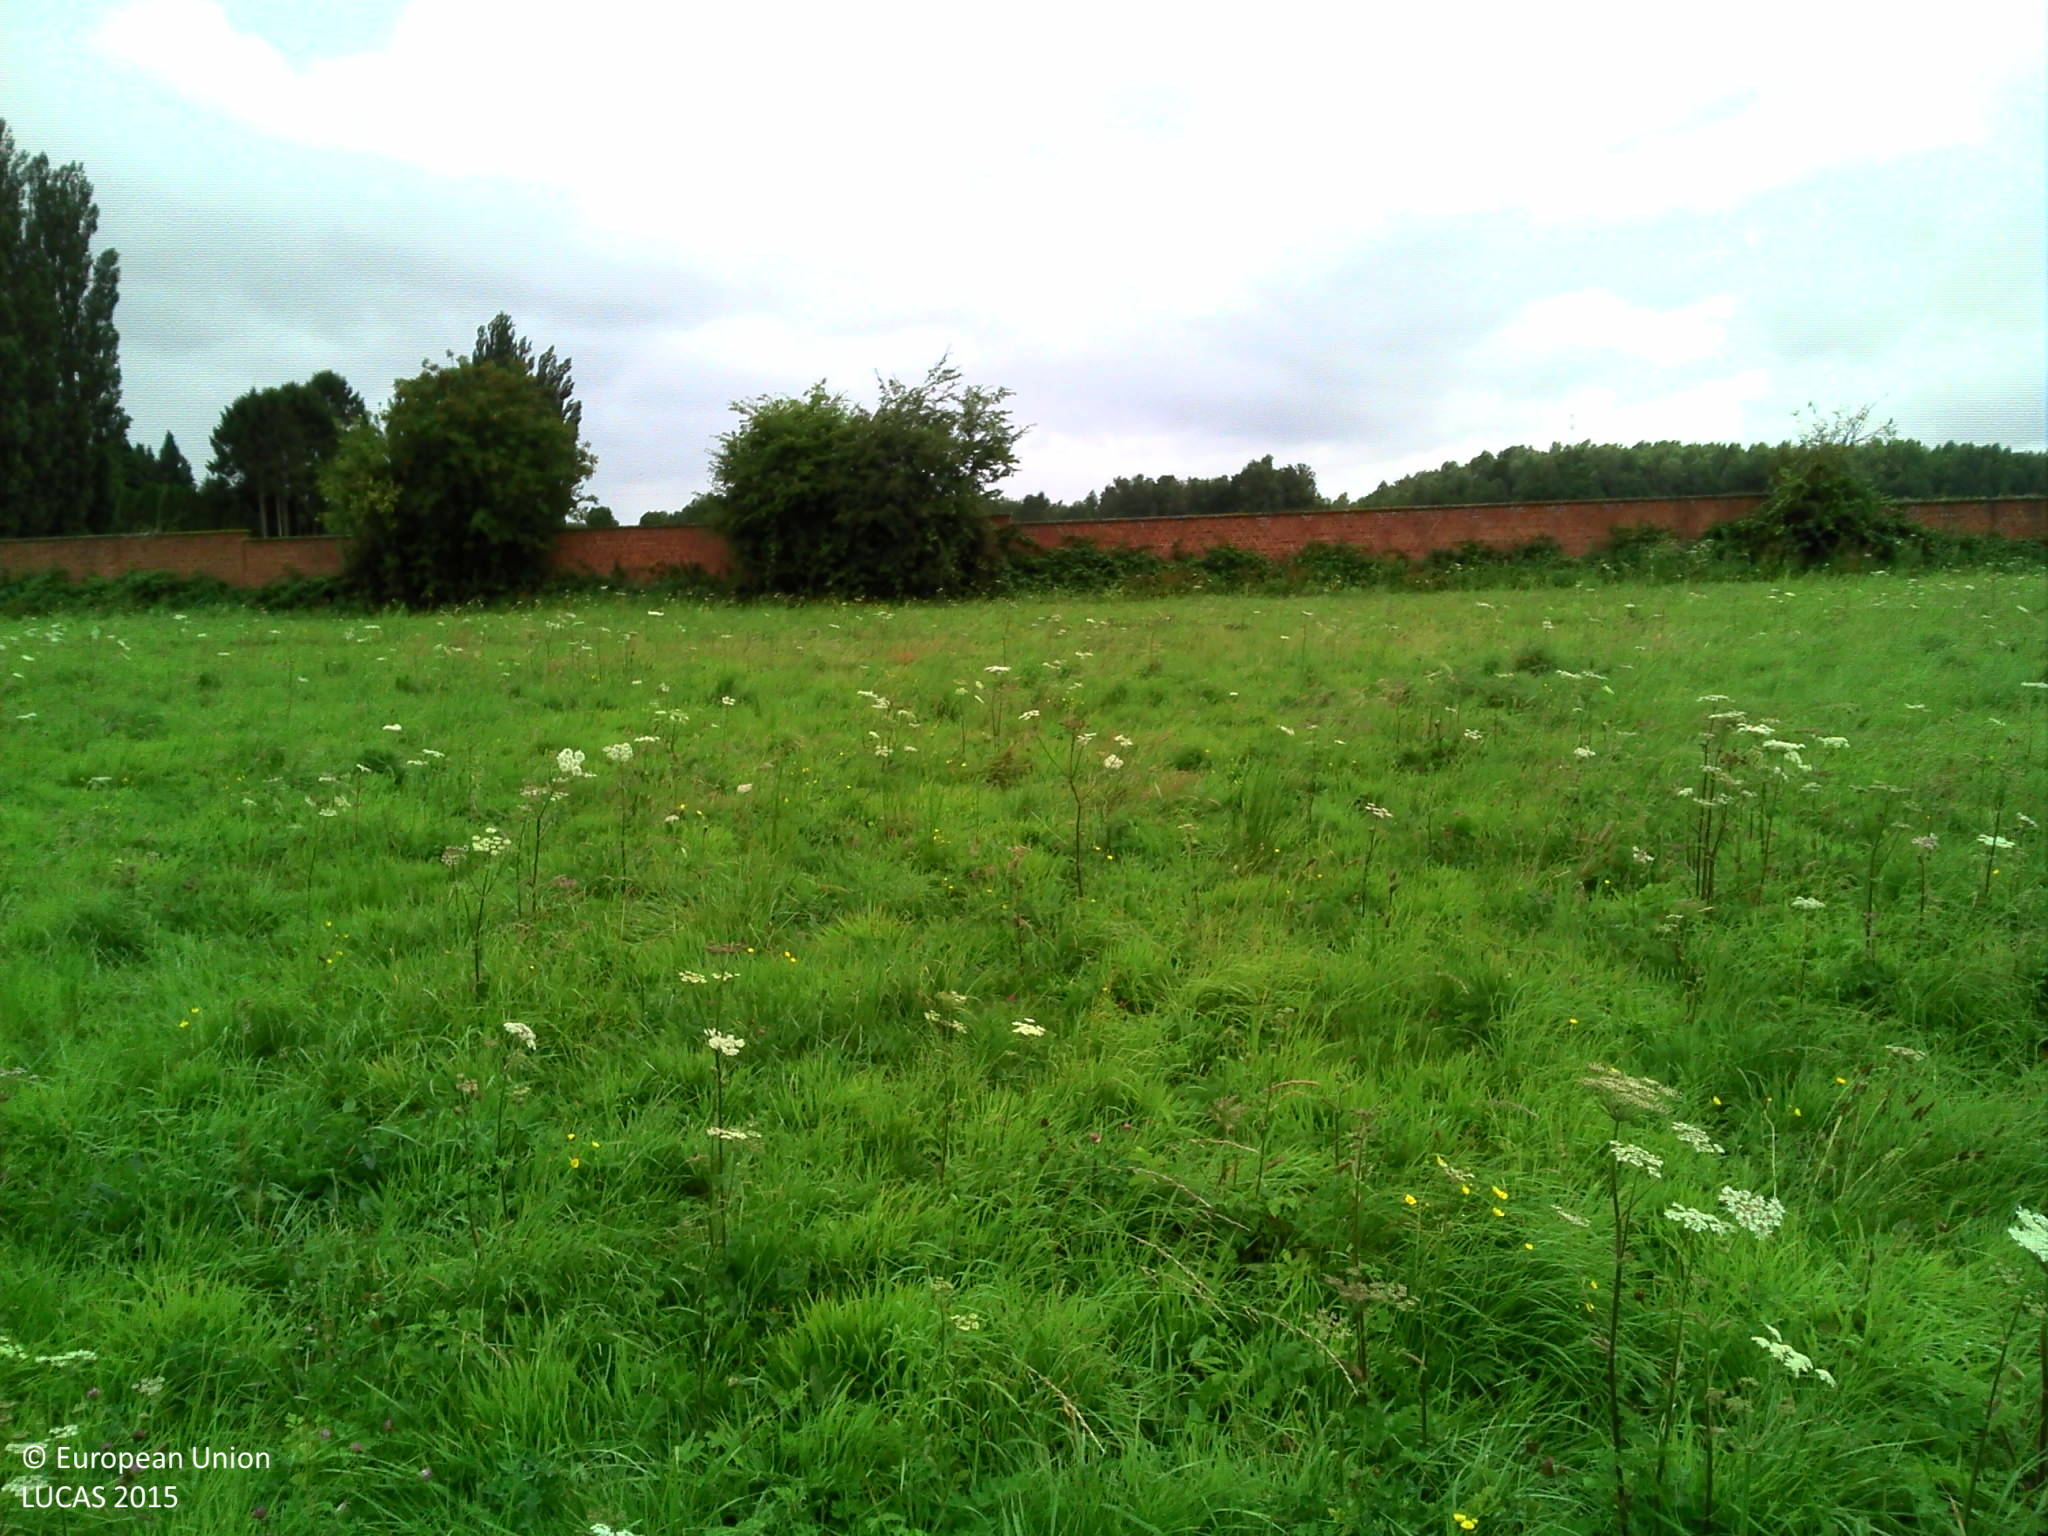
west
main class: Grassland
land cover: Grassland without tree/shrub cover
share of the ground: > 75 %
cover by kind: herbaceous plants 100 %
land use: Community services
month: July
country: BE
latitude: 50.4861
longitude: 4.5415
